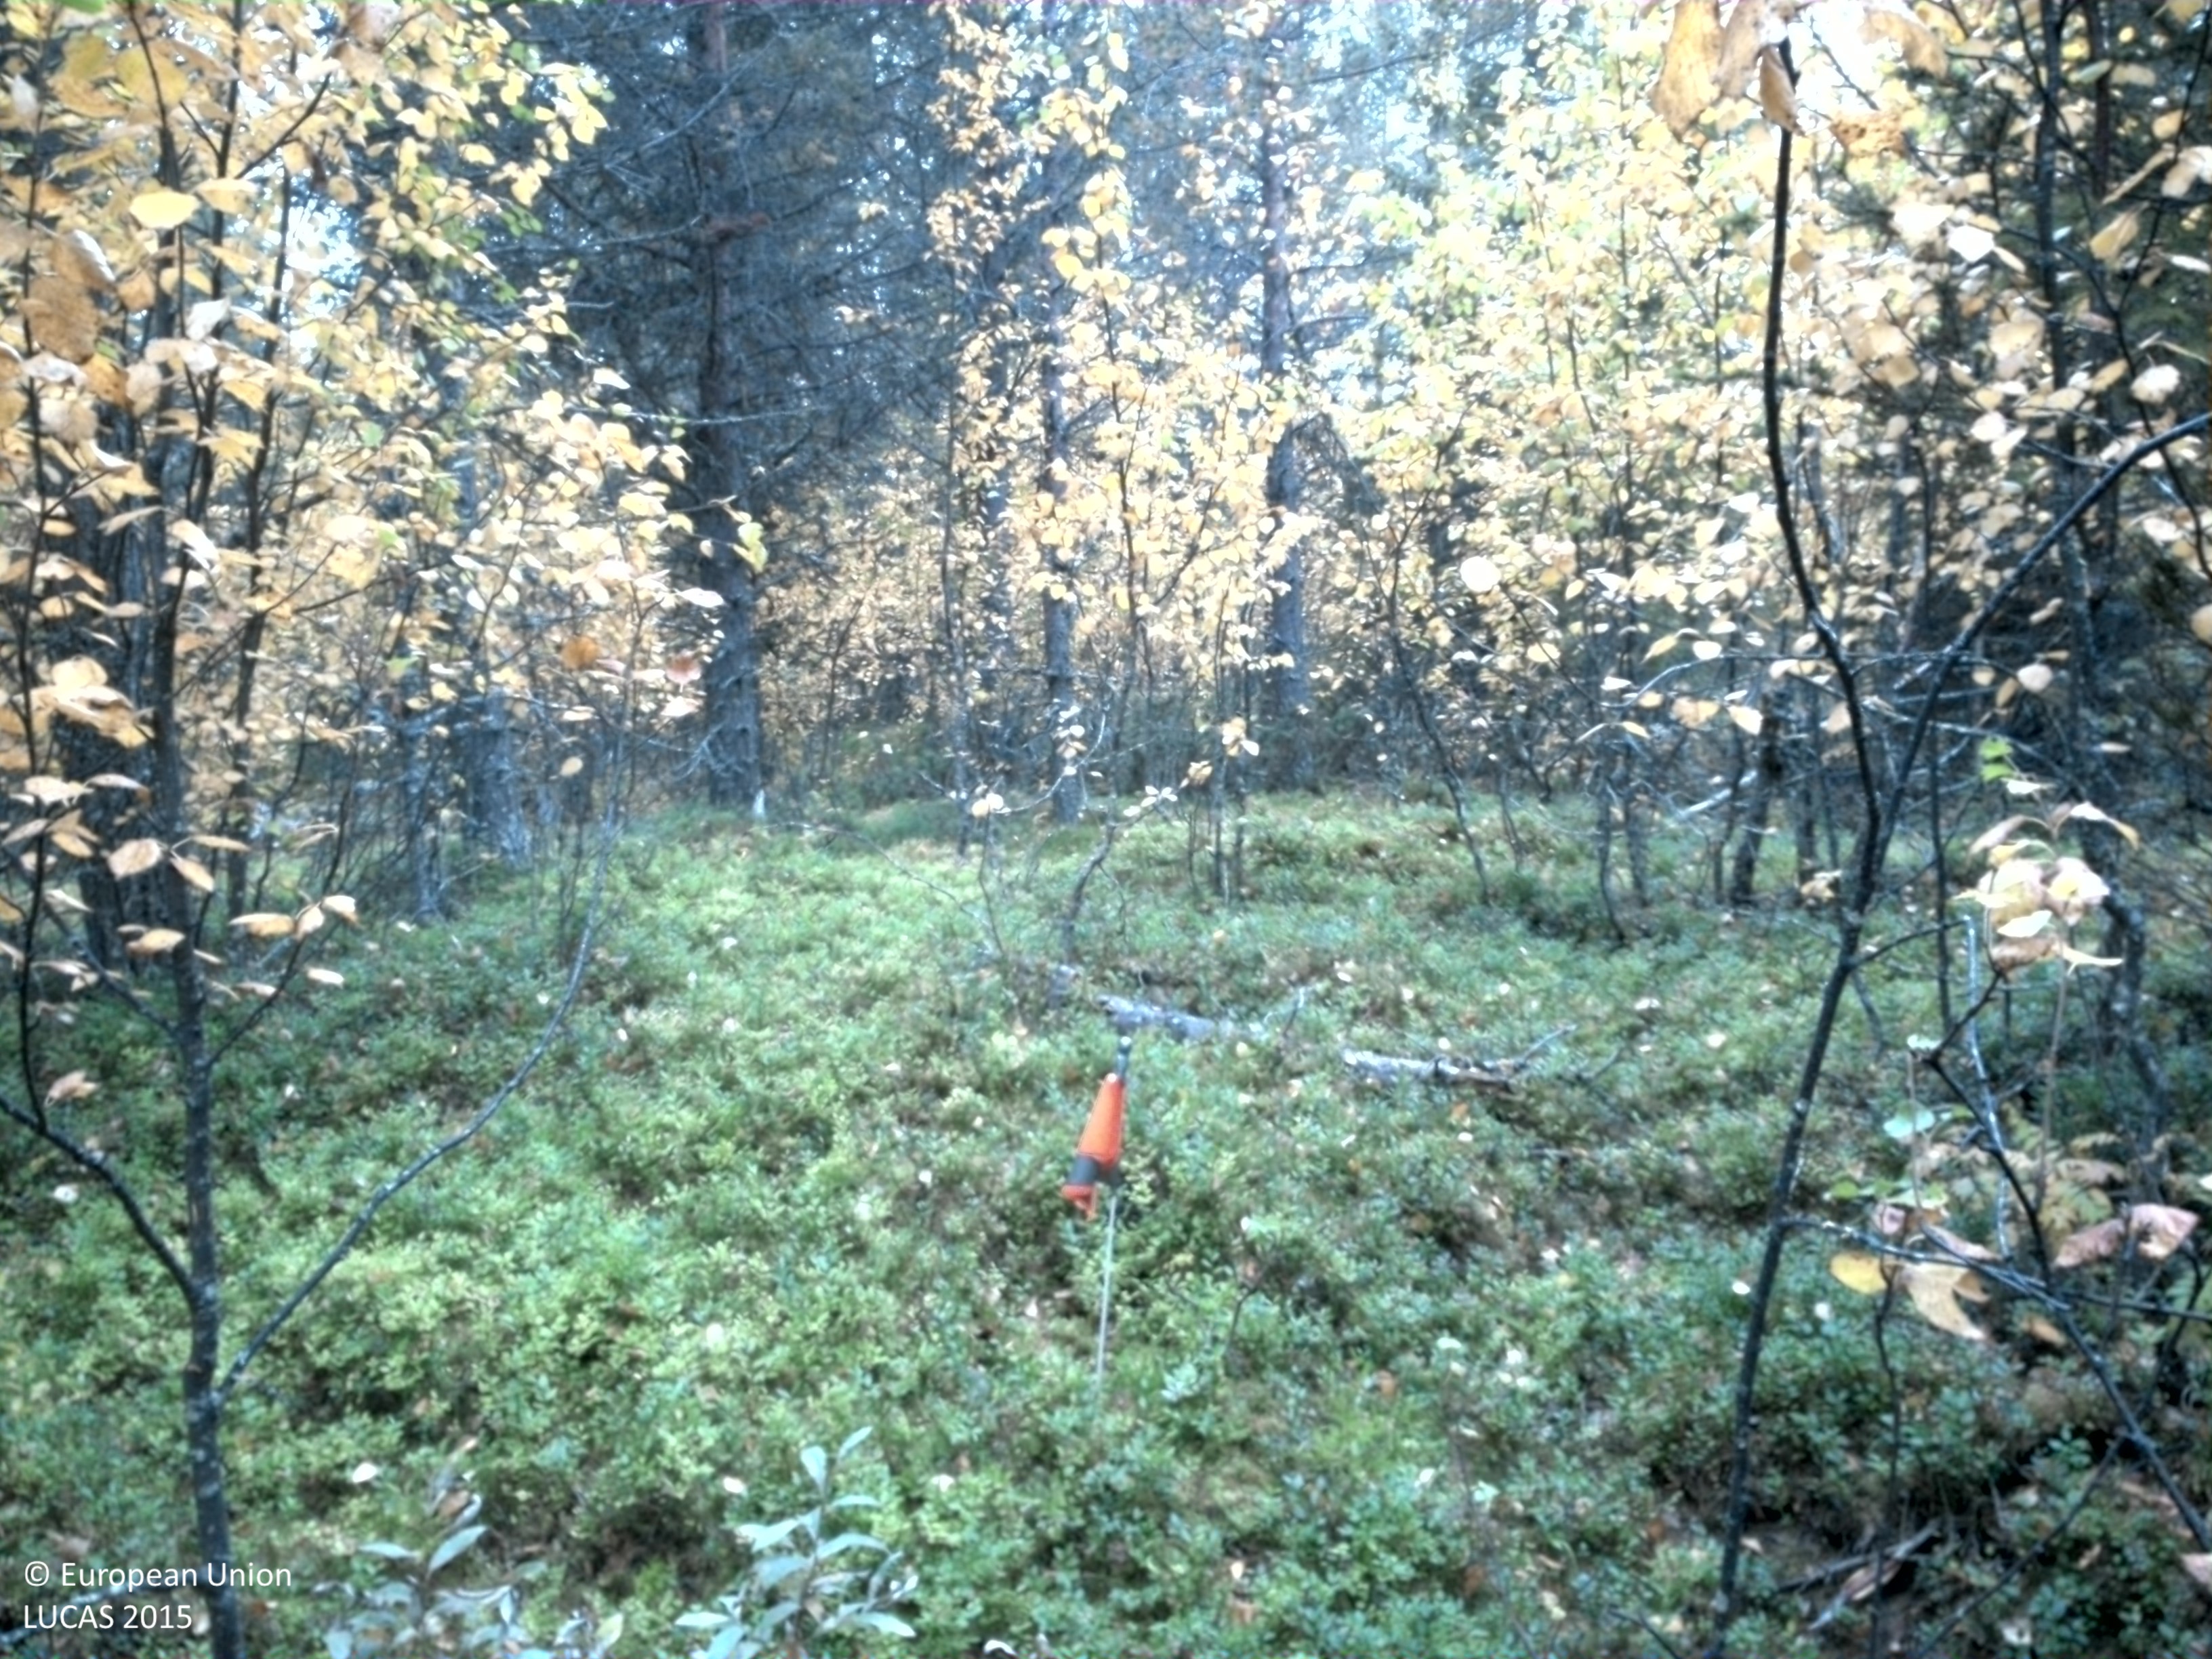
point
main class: Woodland
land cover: Pine dominated mixed woodland
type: boreal forest
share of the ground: 50 - 75 %
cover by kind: shrubs 35 %, coniferous forest trees 25 %, broadleaved forest trees 25 %, lichens and mosses 10 %, herbaceous plants 5 %
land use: Forestry
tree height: > 5 m
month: September
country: SE
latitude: 65.1676
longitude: 16.6003
